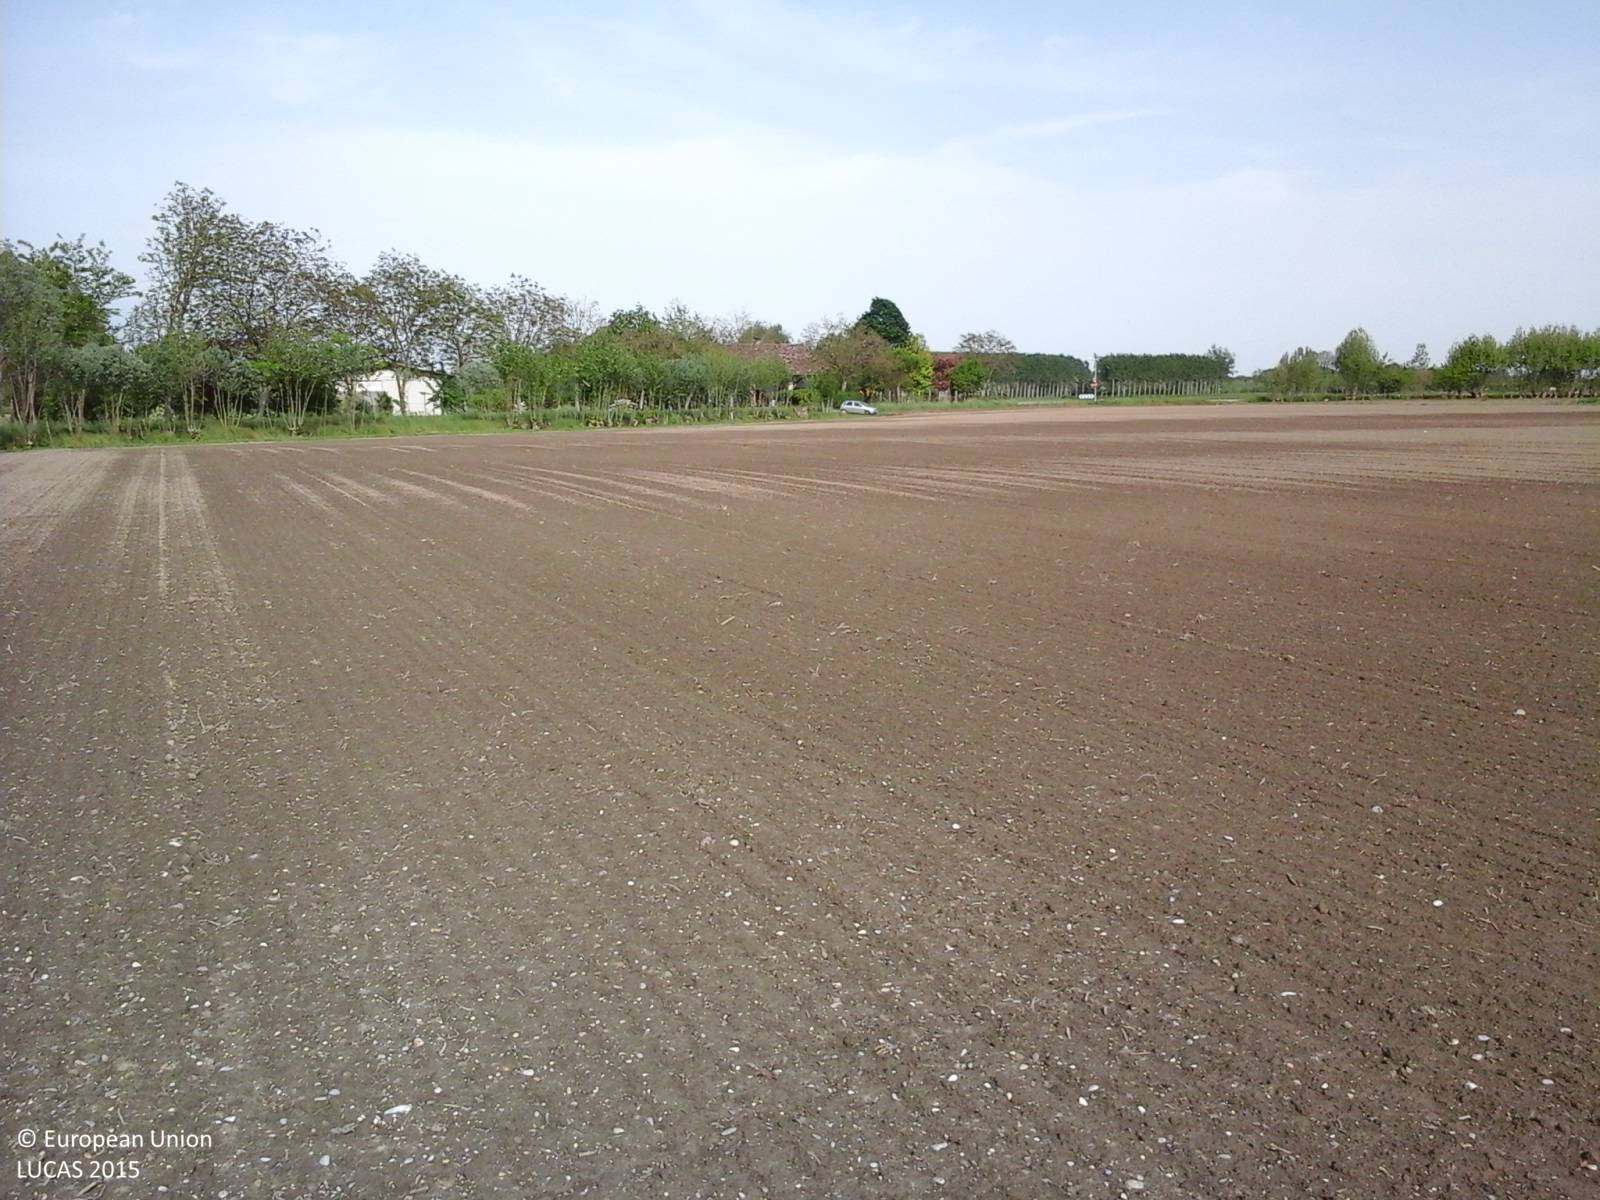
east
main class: Cropland
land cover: Soya
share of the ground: < 10 %
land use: Agriculture (excluding fallow land and kitchen gardens)
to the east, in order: Soya; Grass margins; Managed hedges; Ditches and canals; Grass margins; Paved roads, cycling and walking lanes; Grass margins; Ditches and canals; Artificial constructions in urban areas; Managed hedges; Paved roads, cycling and walking lanes; Grass margins; Tracks; Grass margins; Maize
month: May
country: IT
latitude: 45.8578
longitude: 13.0229
